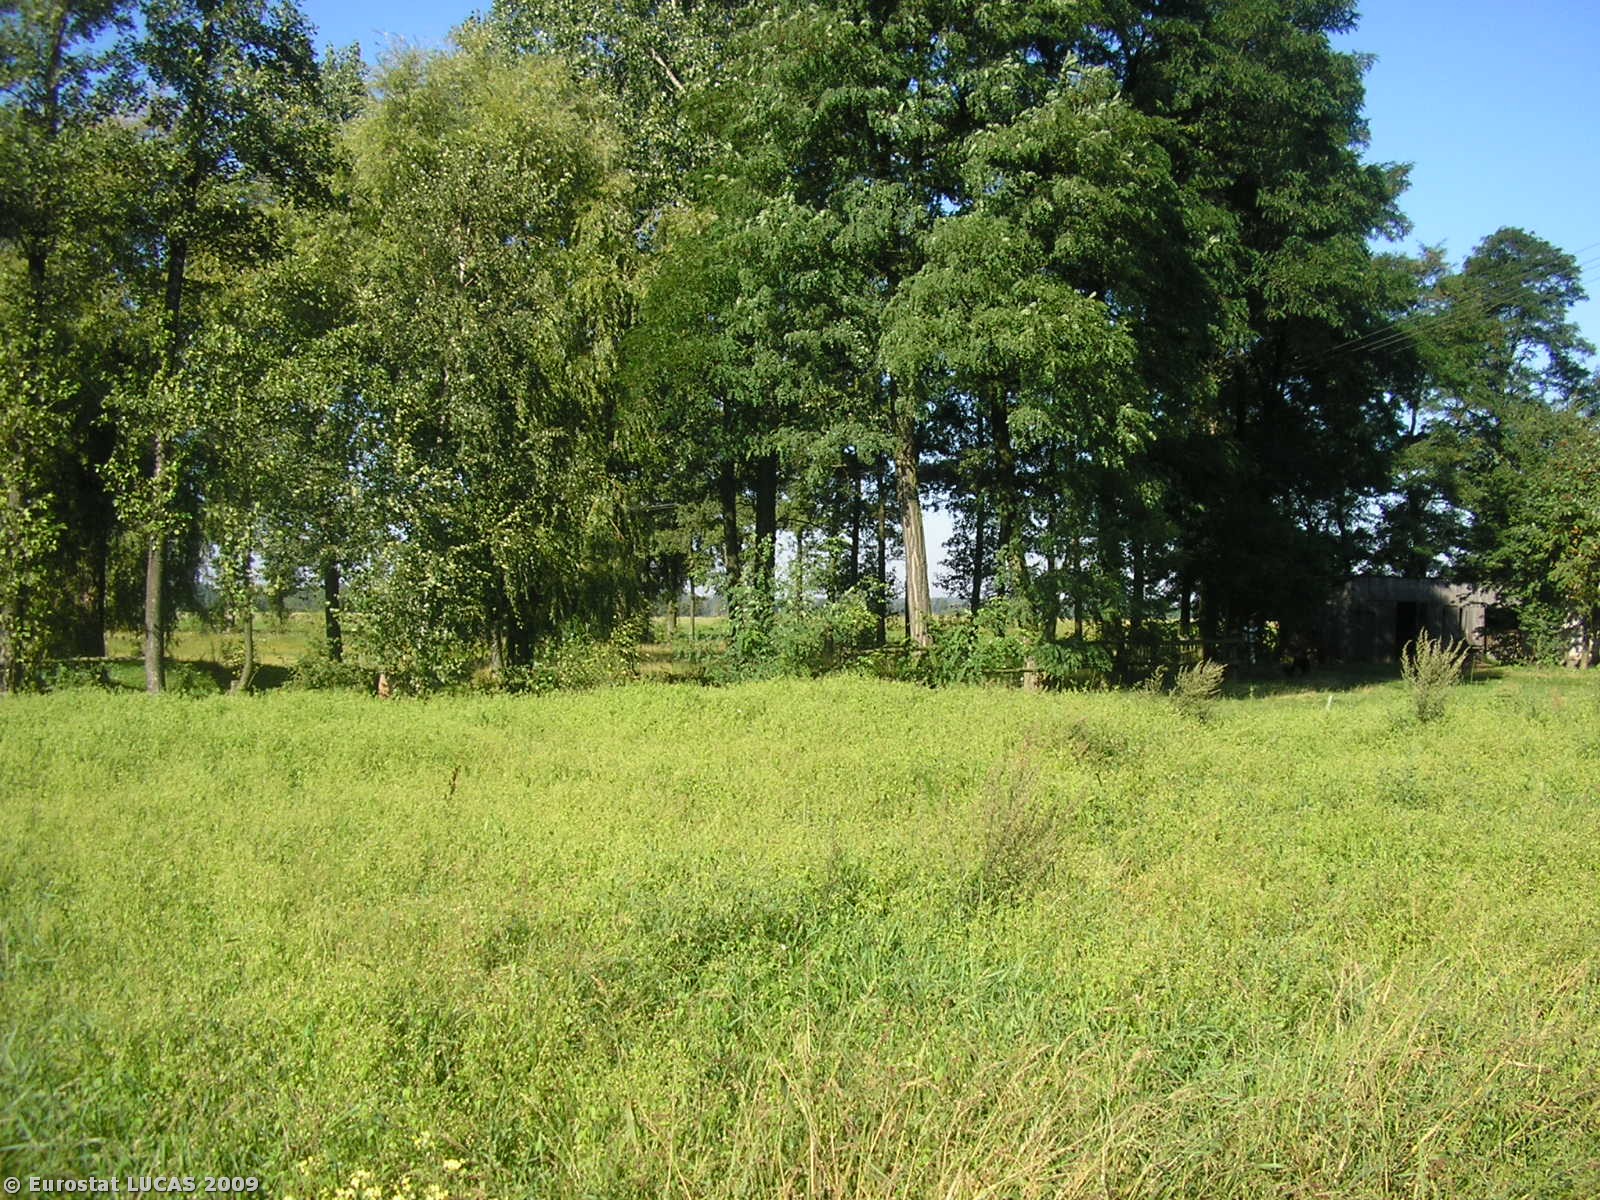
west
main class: Cropland
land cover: Potatoes
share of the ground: 25 - 50 %
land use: Agriculture (excluding fallow land and kitchen gardens)
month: September
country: PL
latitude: 51.9617
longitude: 19.4727
